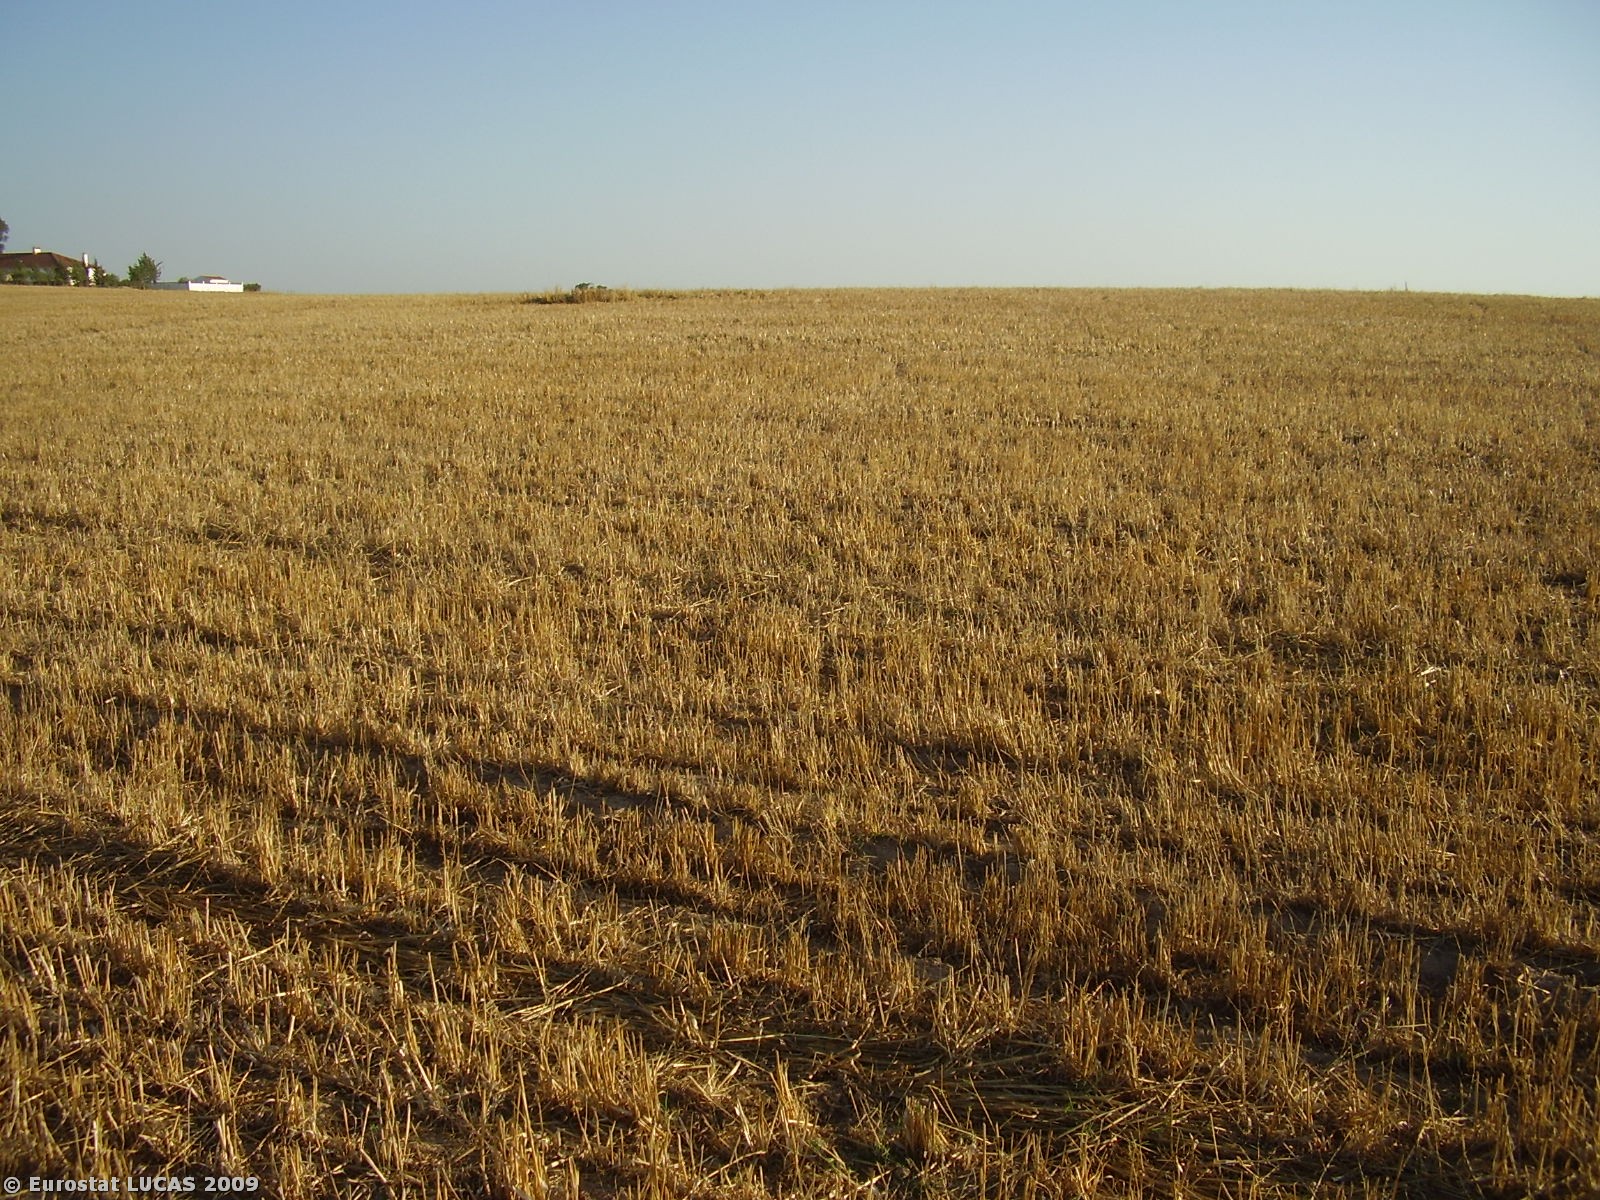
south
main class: Cropland
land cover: Oats
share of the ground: > 75 %
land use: Agriculture (excluding fallow land and kitchen gardens)
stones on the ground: 10 - 25 %
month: July
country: PT
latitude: 38.6192
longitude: -7.8293
